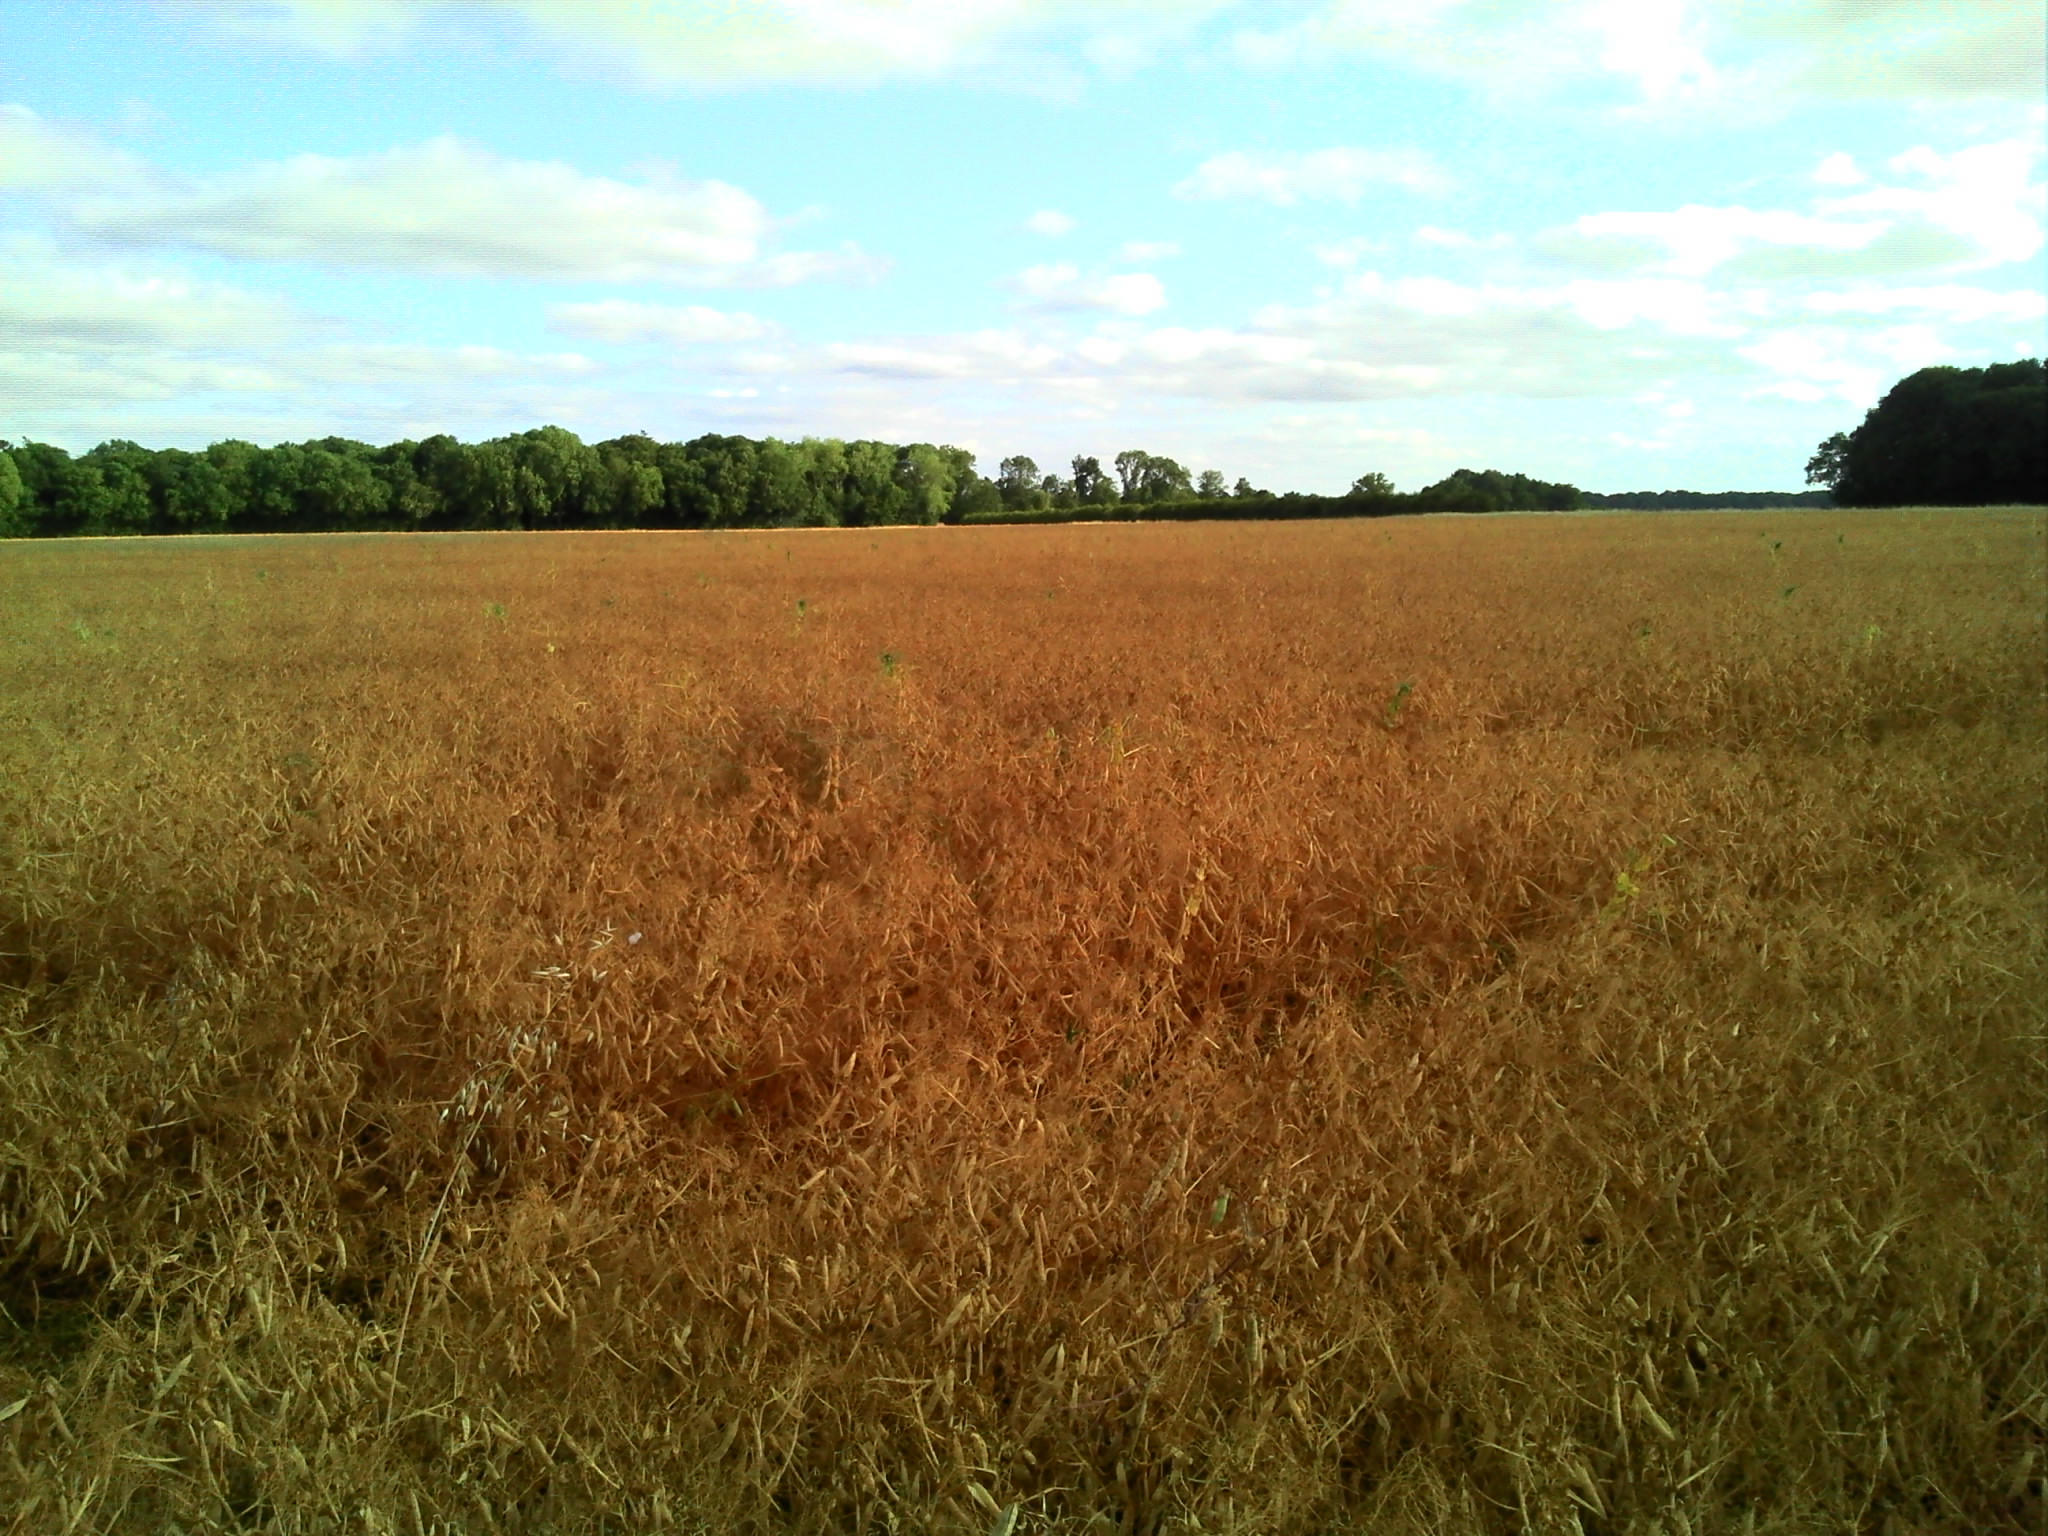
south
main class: Cropland
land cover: Dry pulses
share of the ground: > 75 %
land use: Agriculture (excluding fallow land and kitchen gardens)
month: July
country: FR
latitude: 48.6876
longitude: 0.7808
